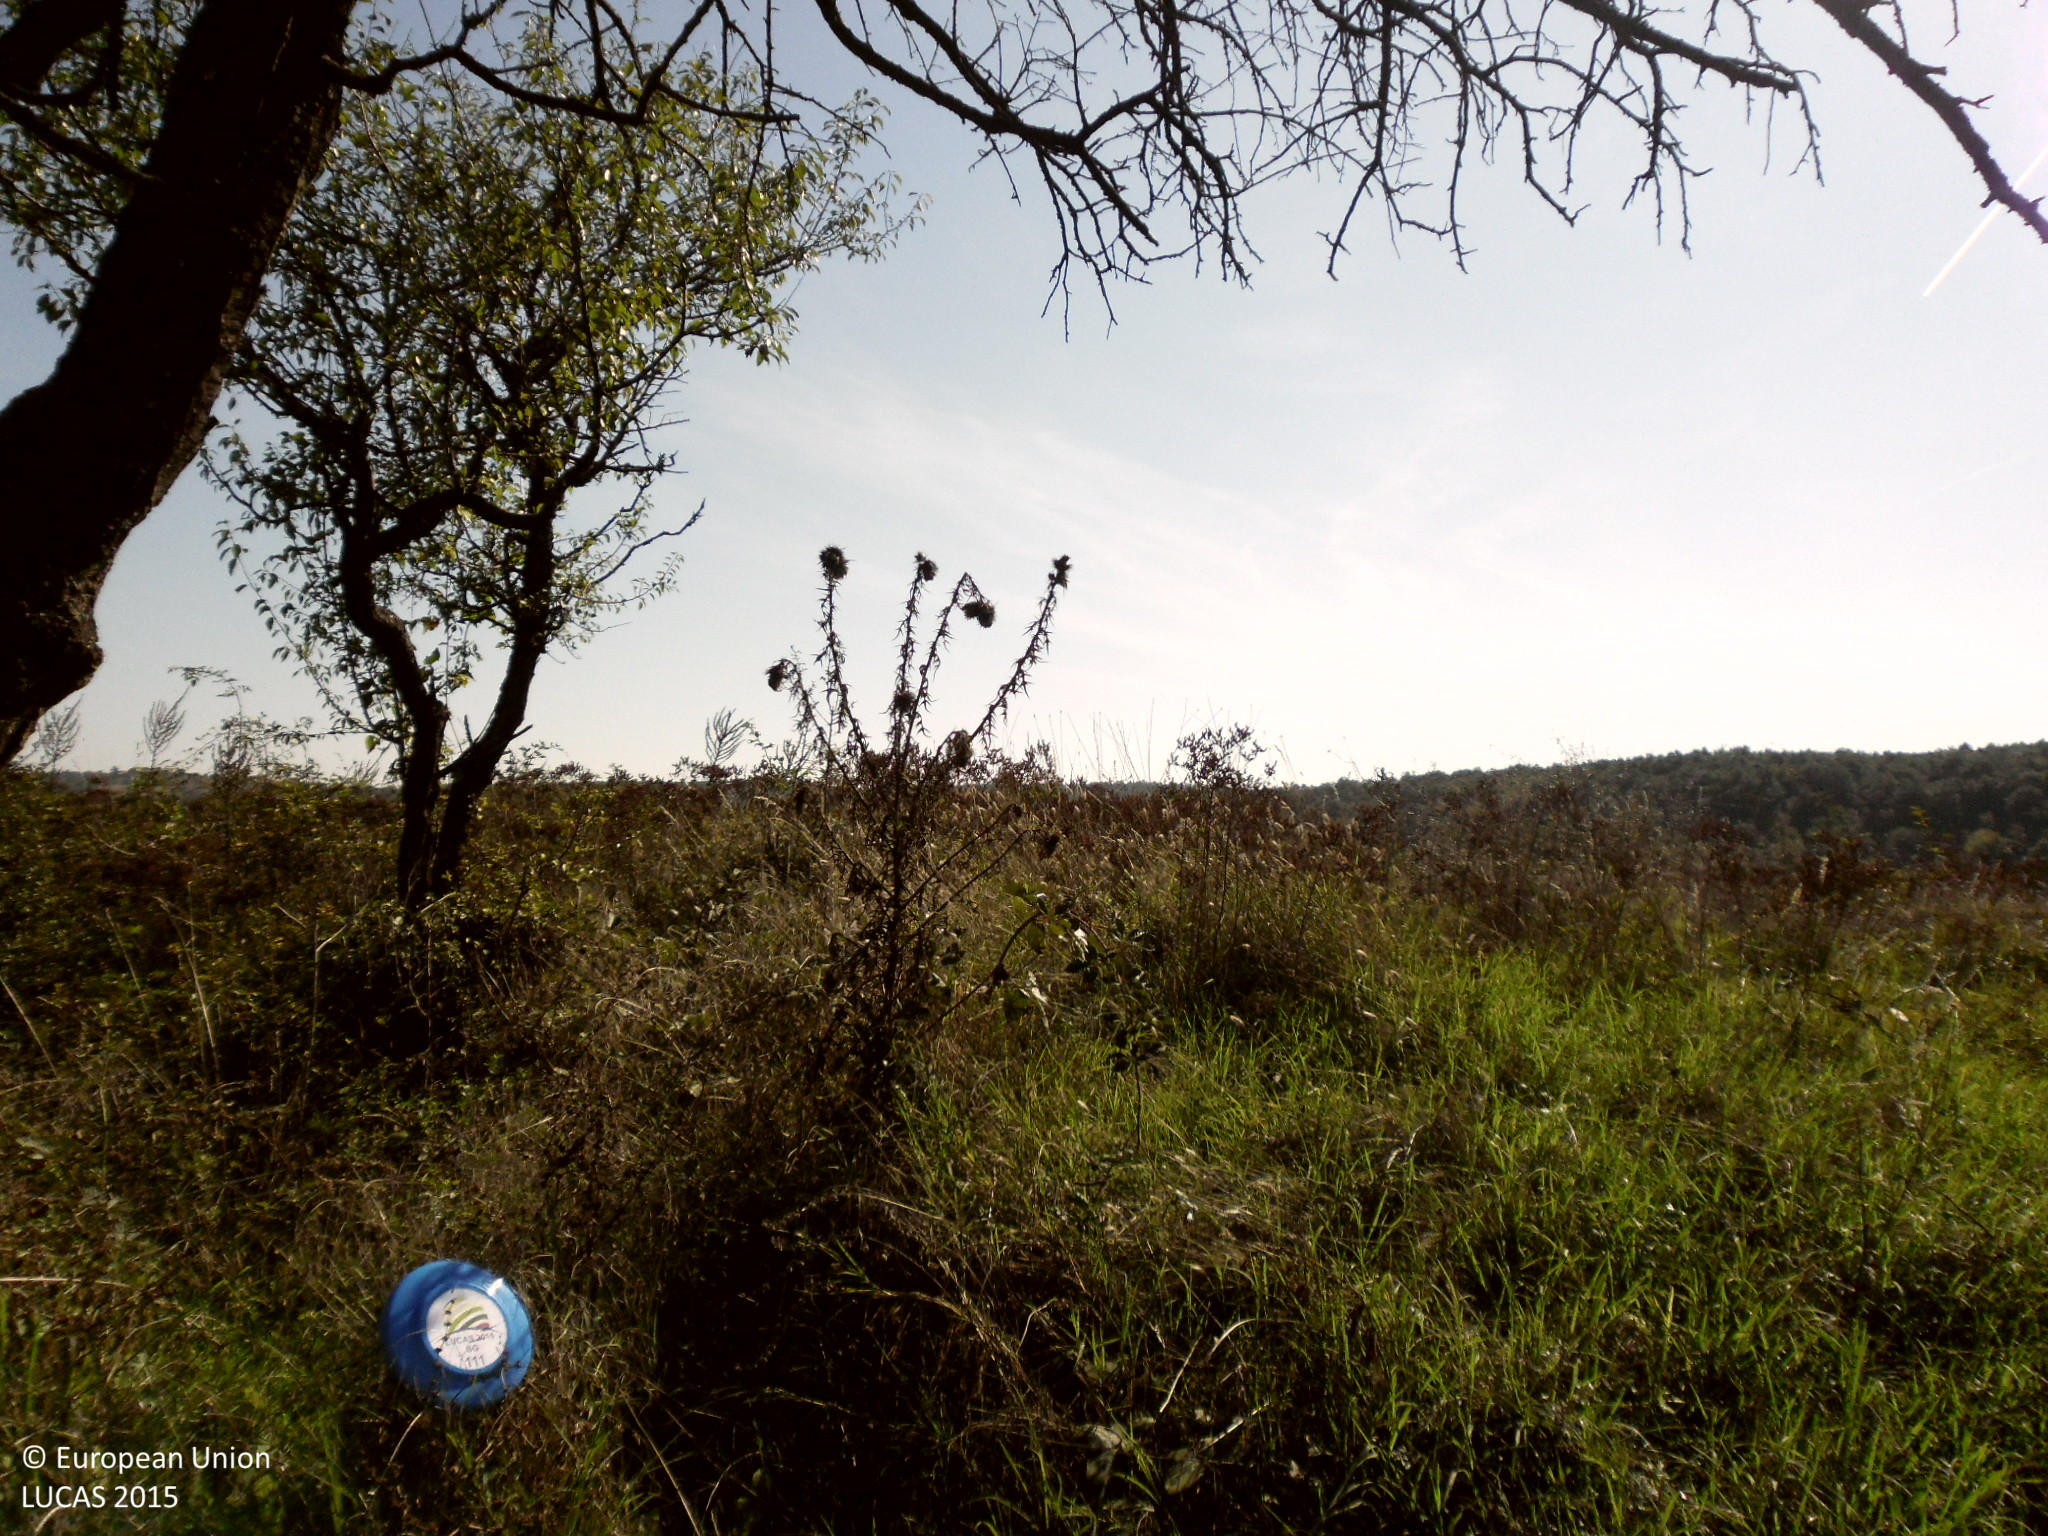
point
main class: Grassland
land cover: Grassland with sparse tree/shrub cover
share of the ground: > 75 %
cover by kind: herbaceous plants 90 %, broadleaved forest trees 5 %, shrubs 5 %
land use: Agriculture (excluding fallow land and kitchen gardens)
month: October
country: BG
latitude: 43.6078
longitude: 22.8090
